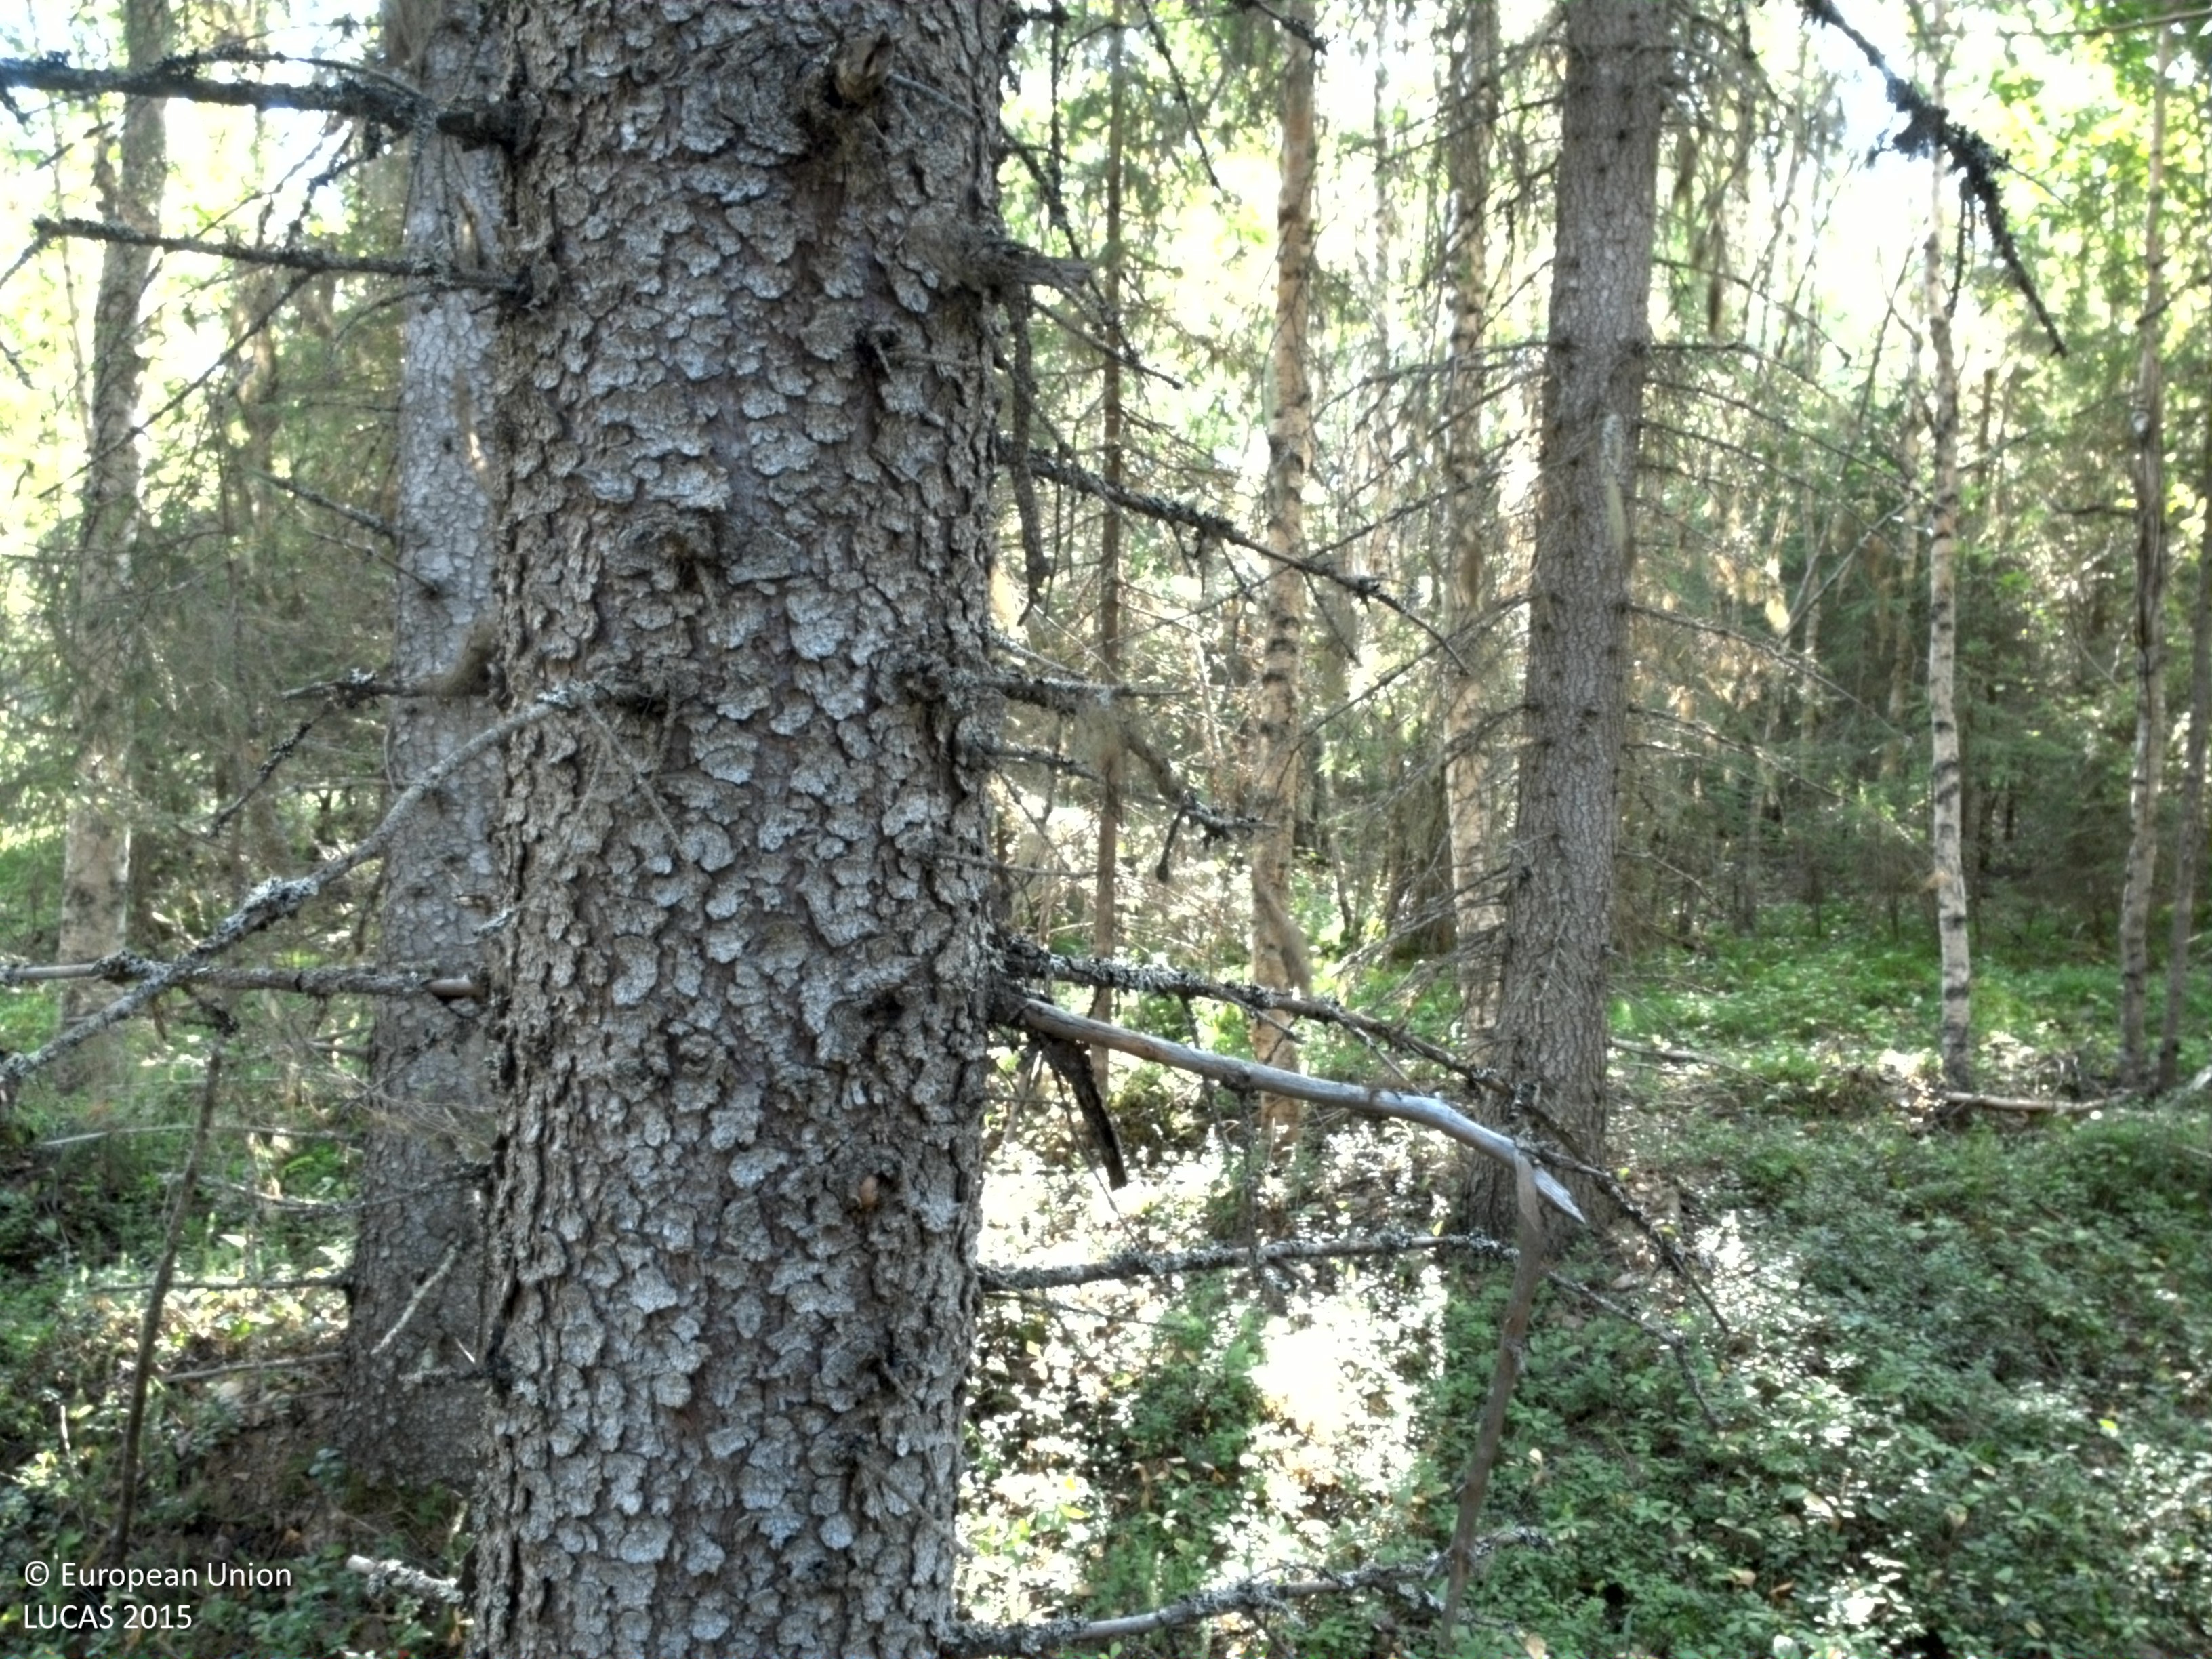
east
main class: Woodland
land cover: Spruce dominated coniferous woodland
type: boreal forest
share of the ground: 50 - 75 %
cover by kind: coniferous forest trees 50 %, shrubs 45 %, broadleaved forest trees 5 %
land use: Forestry
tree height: > 5 m
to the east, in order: Spruce dominated coniferous woodland; Ditches and canals; Spruce dominated mixed woodland; Grassland with sparse tree/shrub cover; Spruce dominated mixed woodland; Grassland with sparse tree/shrub cover; Spruce dominated mixed woodland; Ditches and canals; Spruce dominated mixed woodland; Ditches and canals; Pine dominated mixed woodland; Pine dominated coniferous woodland
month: August
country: SE
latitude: 66.1280
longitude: 22.6672
